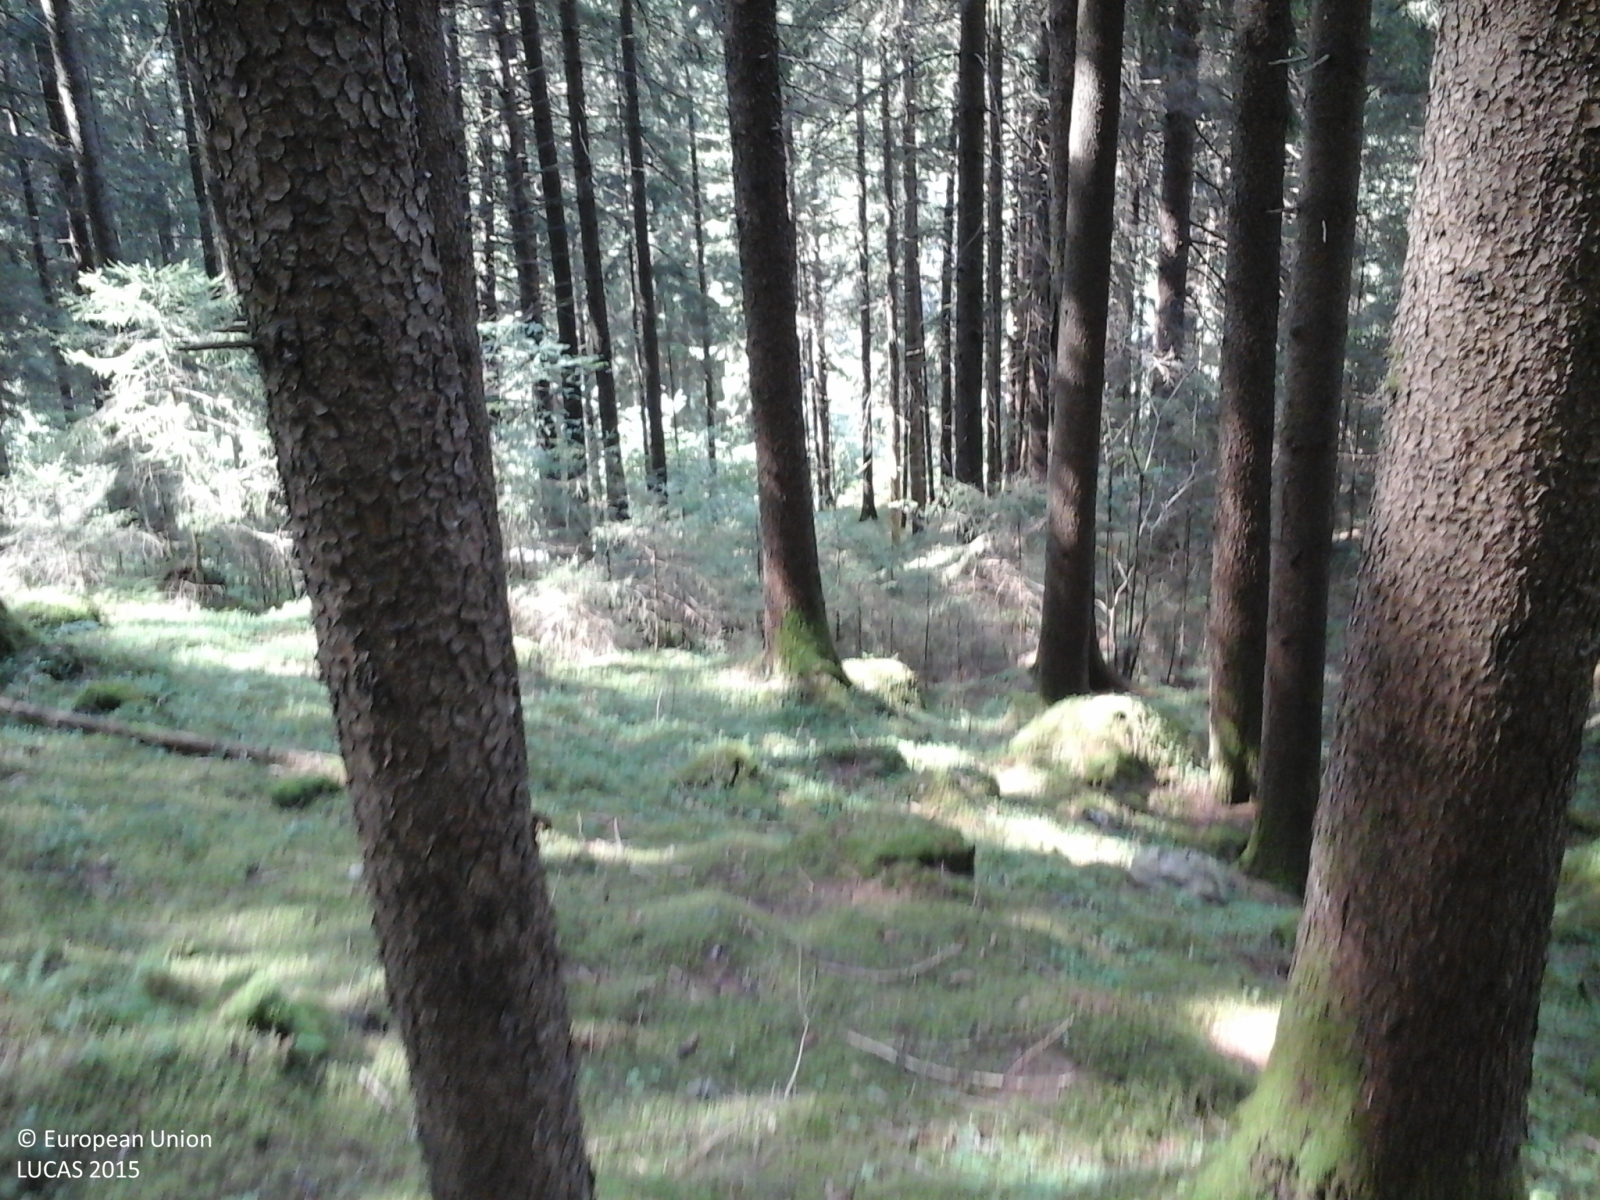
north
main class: Woodland
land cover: Spruce dominated coniferous woodland
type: alpine coniferous forest
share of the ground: > 75 %
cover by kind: coniferous forest trees 100 %
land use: Forestry
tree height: > 5 m
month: July
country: IT
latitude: 46.8050
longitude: 11.7671
